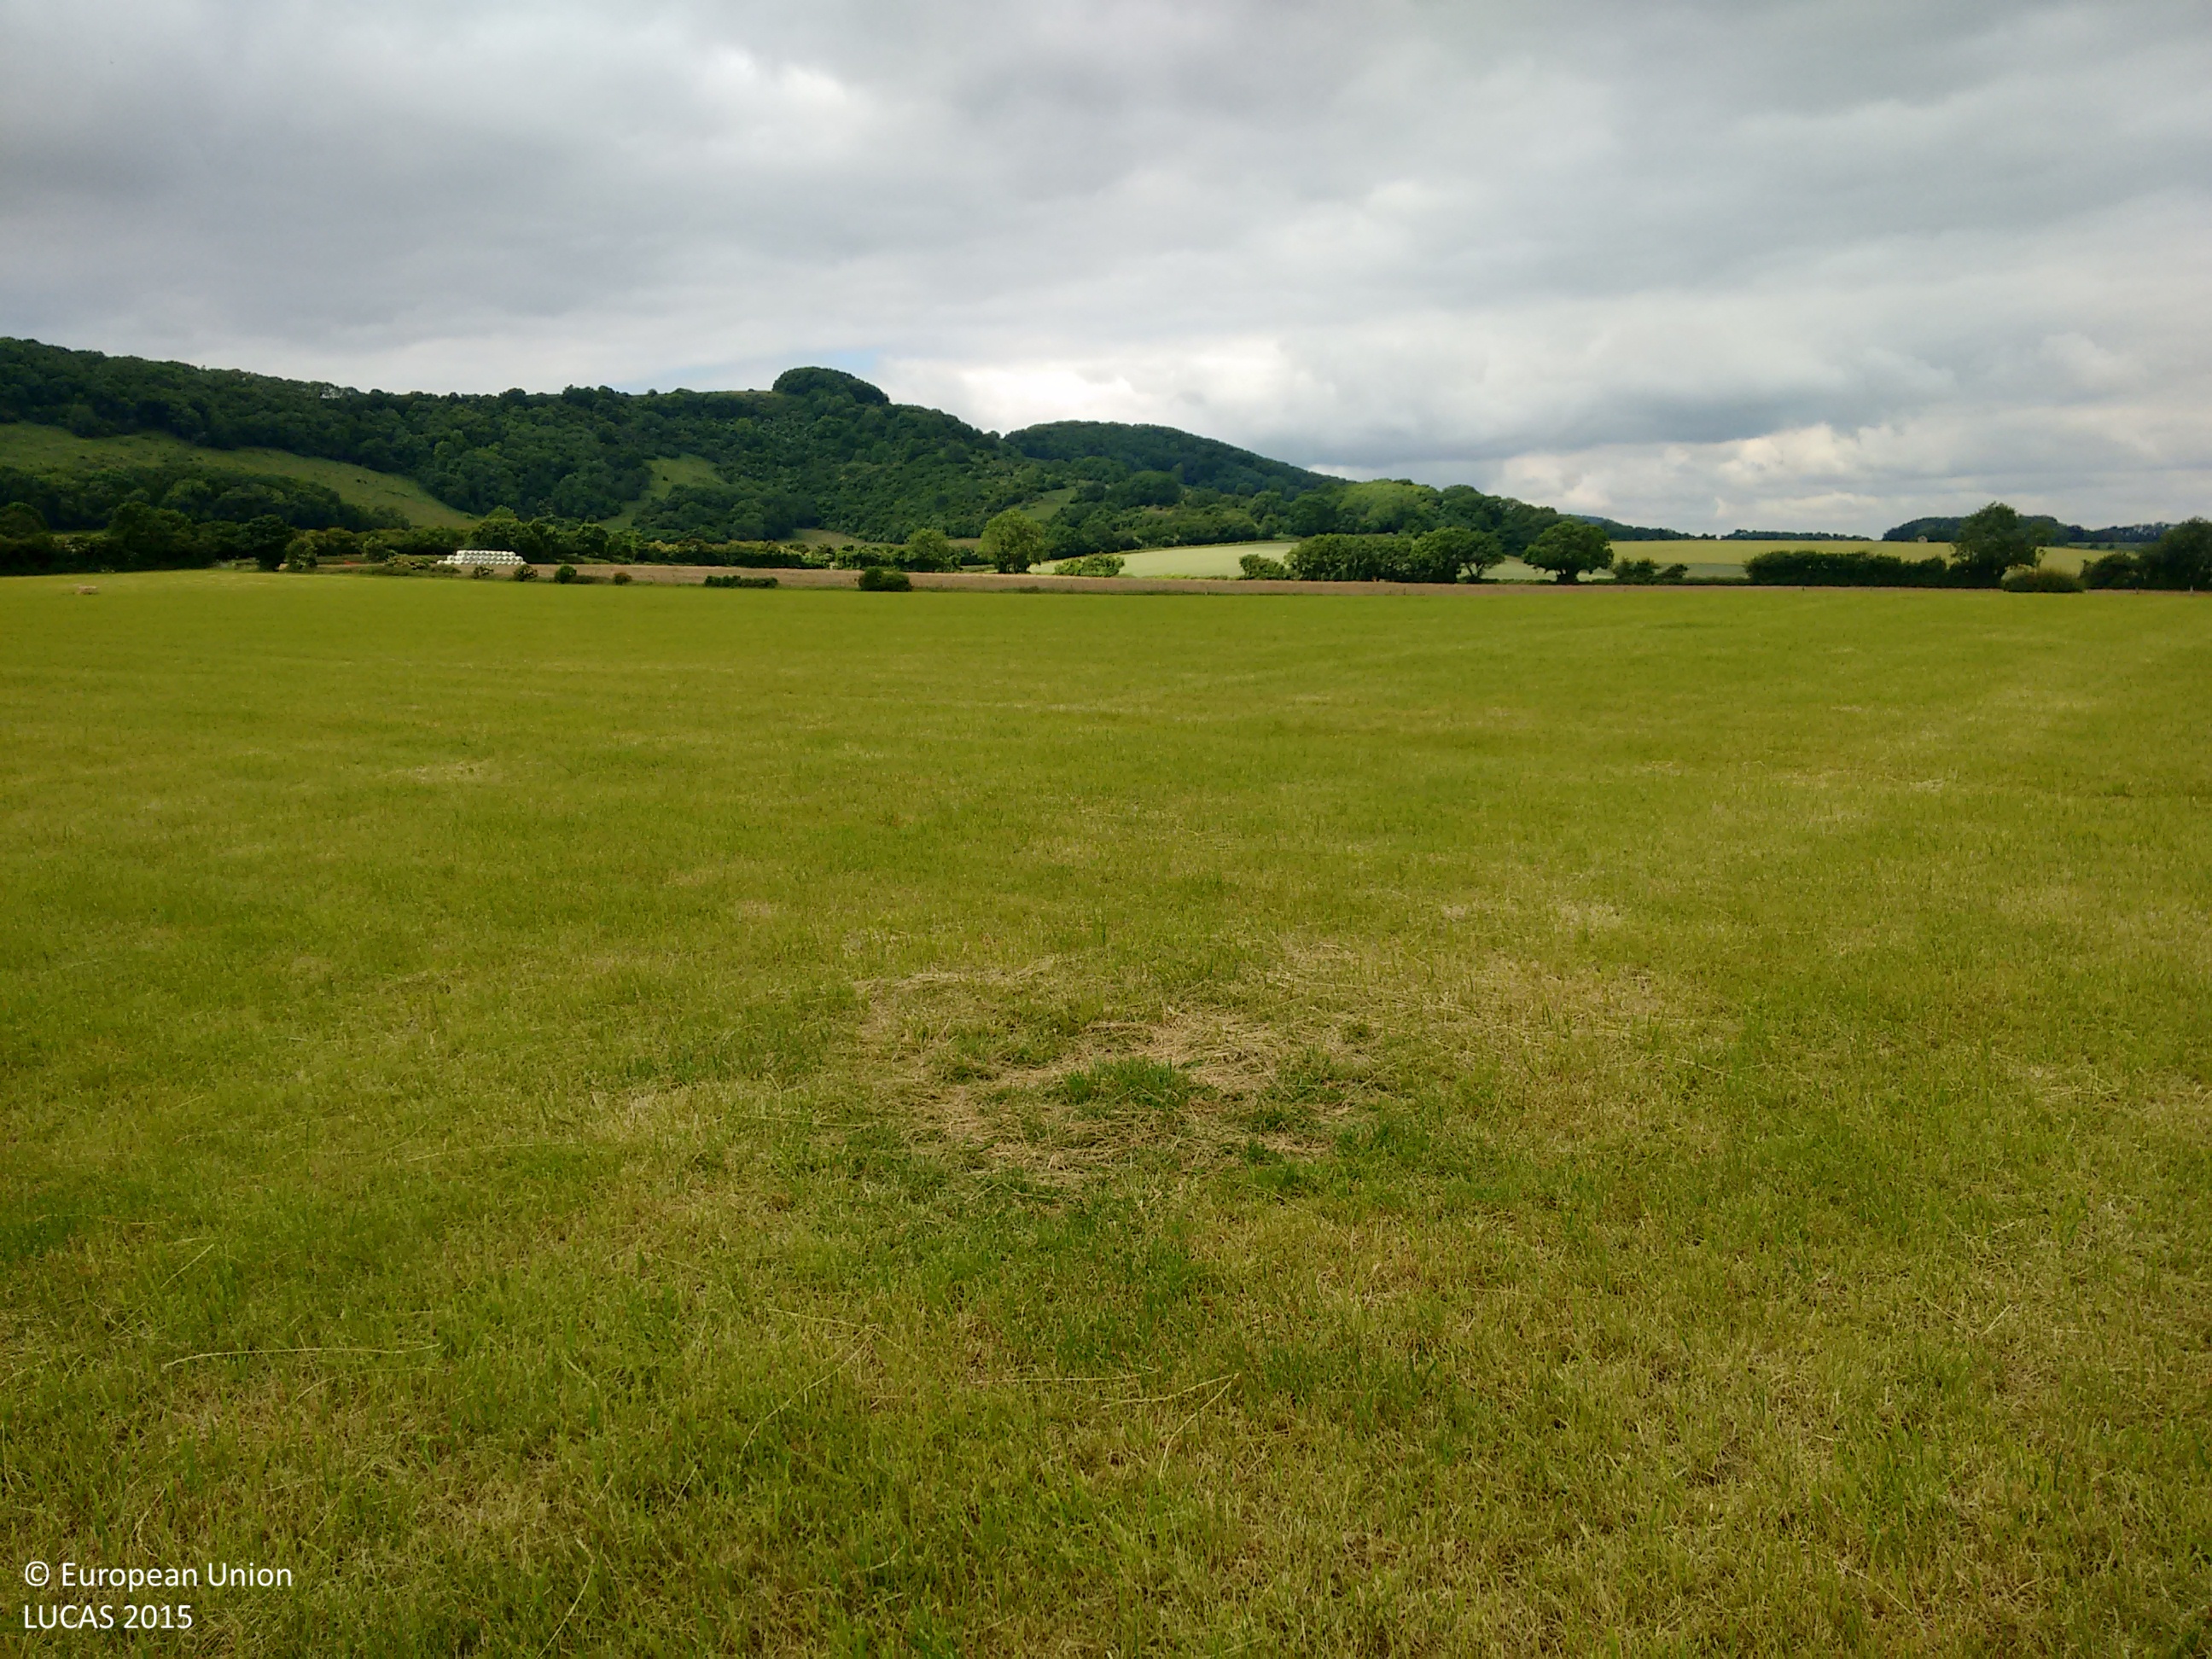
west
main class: Grassland
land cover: Grassland without tree/shrub cover
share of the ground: > 75 %
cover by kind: herbaceous plants 100 %
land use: Agriculture (excluding fallow land and kitchen gardens)
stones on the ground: < 10 %
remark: Harvested field
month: June
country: GB
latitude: 50.9007
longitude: -0.0292
